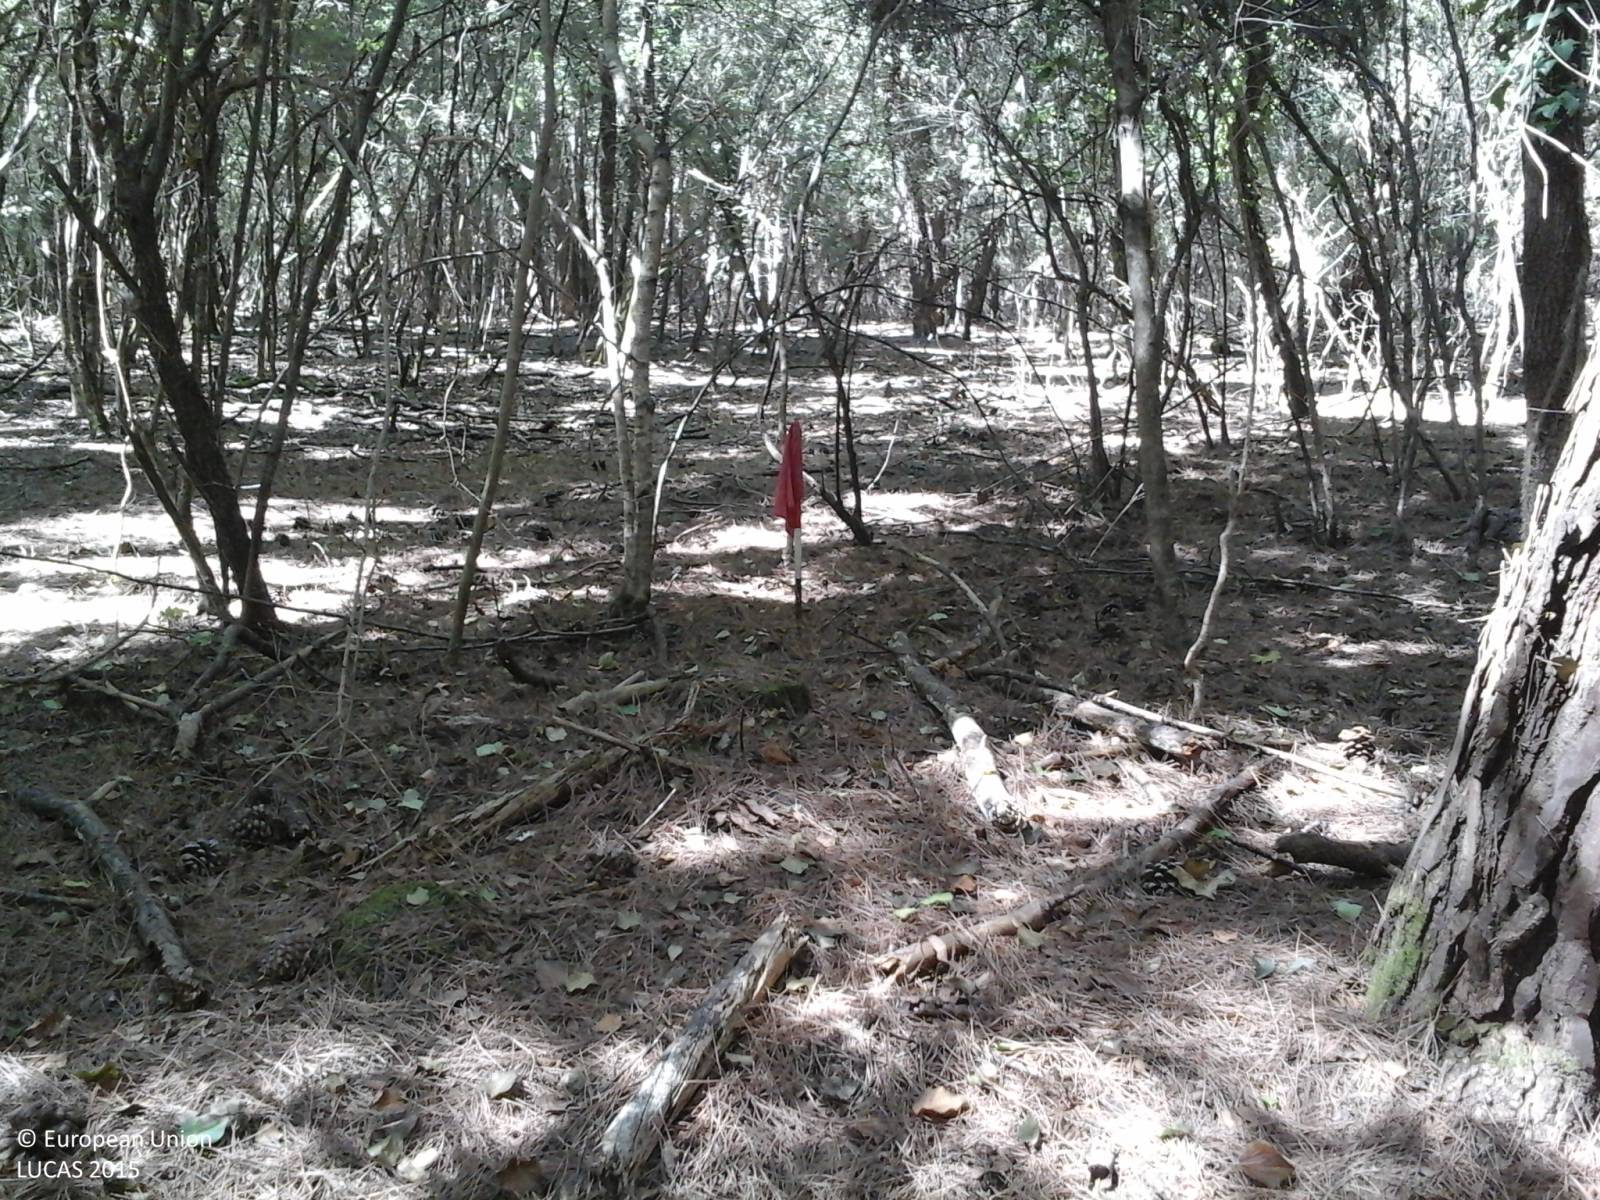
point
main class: Woodland
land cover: Pine dominated mixed woodland
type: coniferous forest of the mediterranean region
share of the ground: > 75 %
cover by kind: coniferous forest trees 75 %, broadleaved forest trees 25 %
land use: Semi-natural and natural areas not in use
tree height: > 5 m
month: August
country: IT
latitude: 41.3059
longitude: 13.0571
